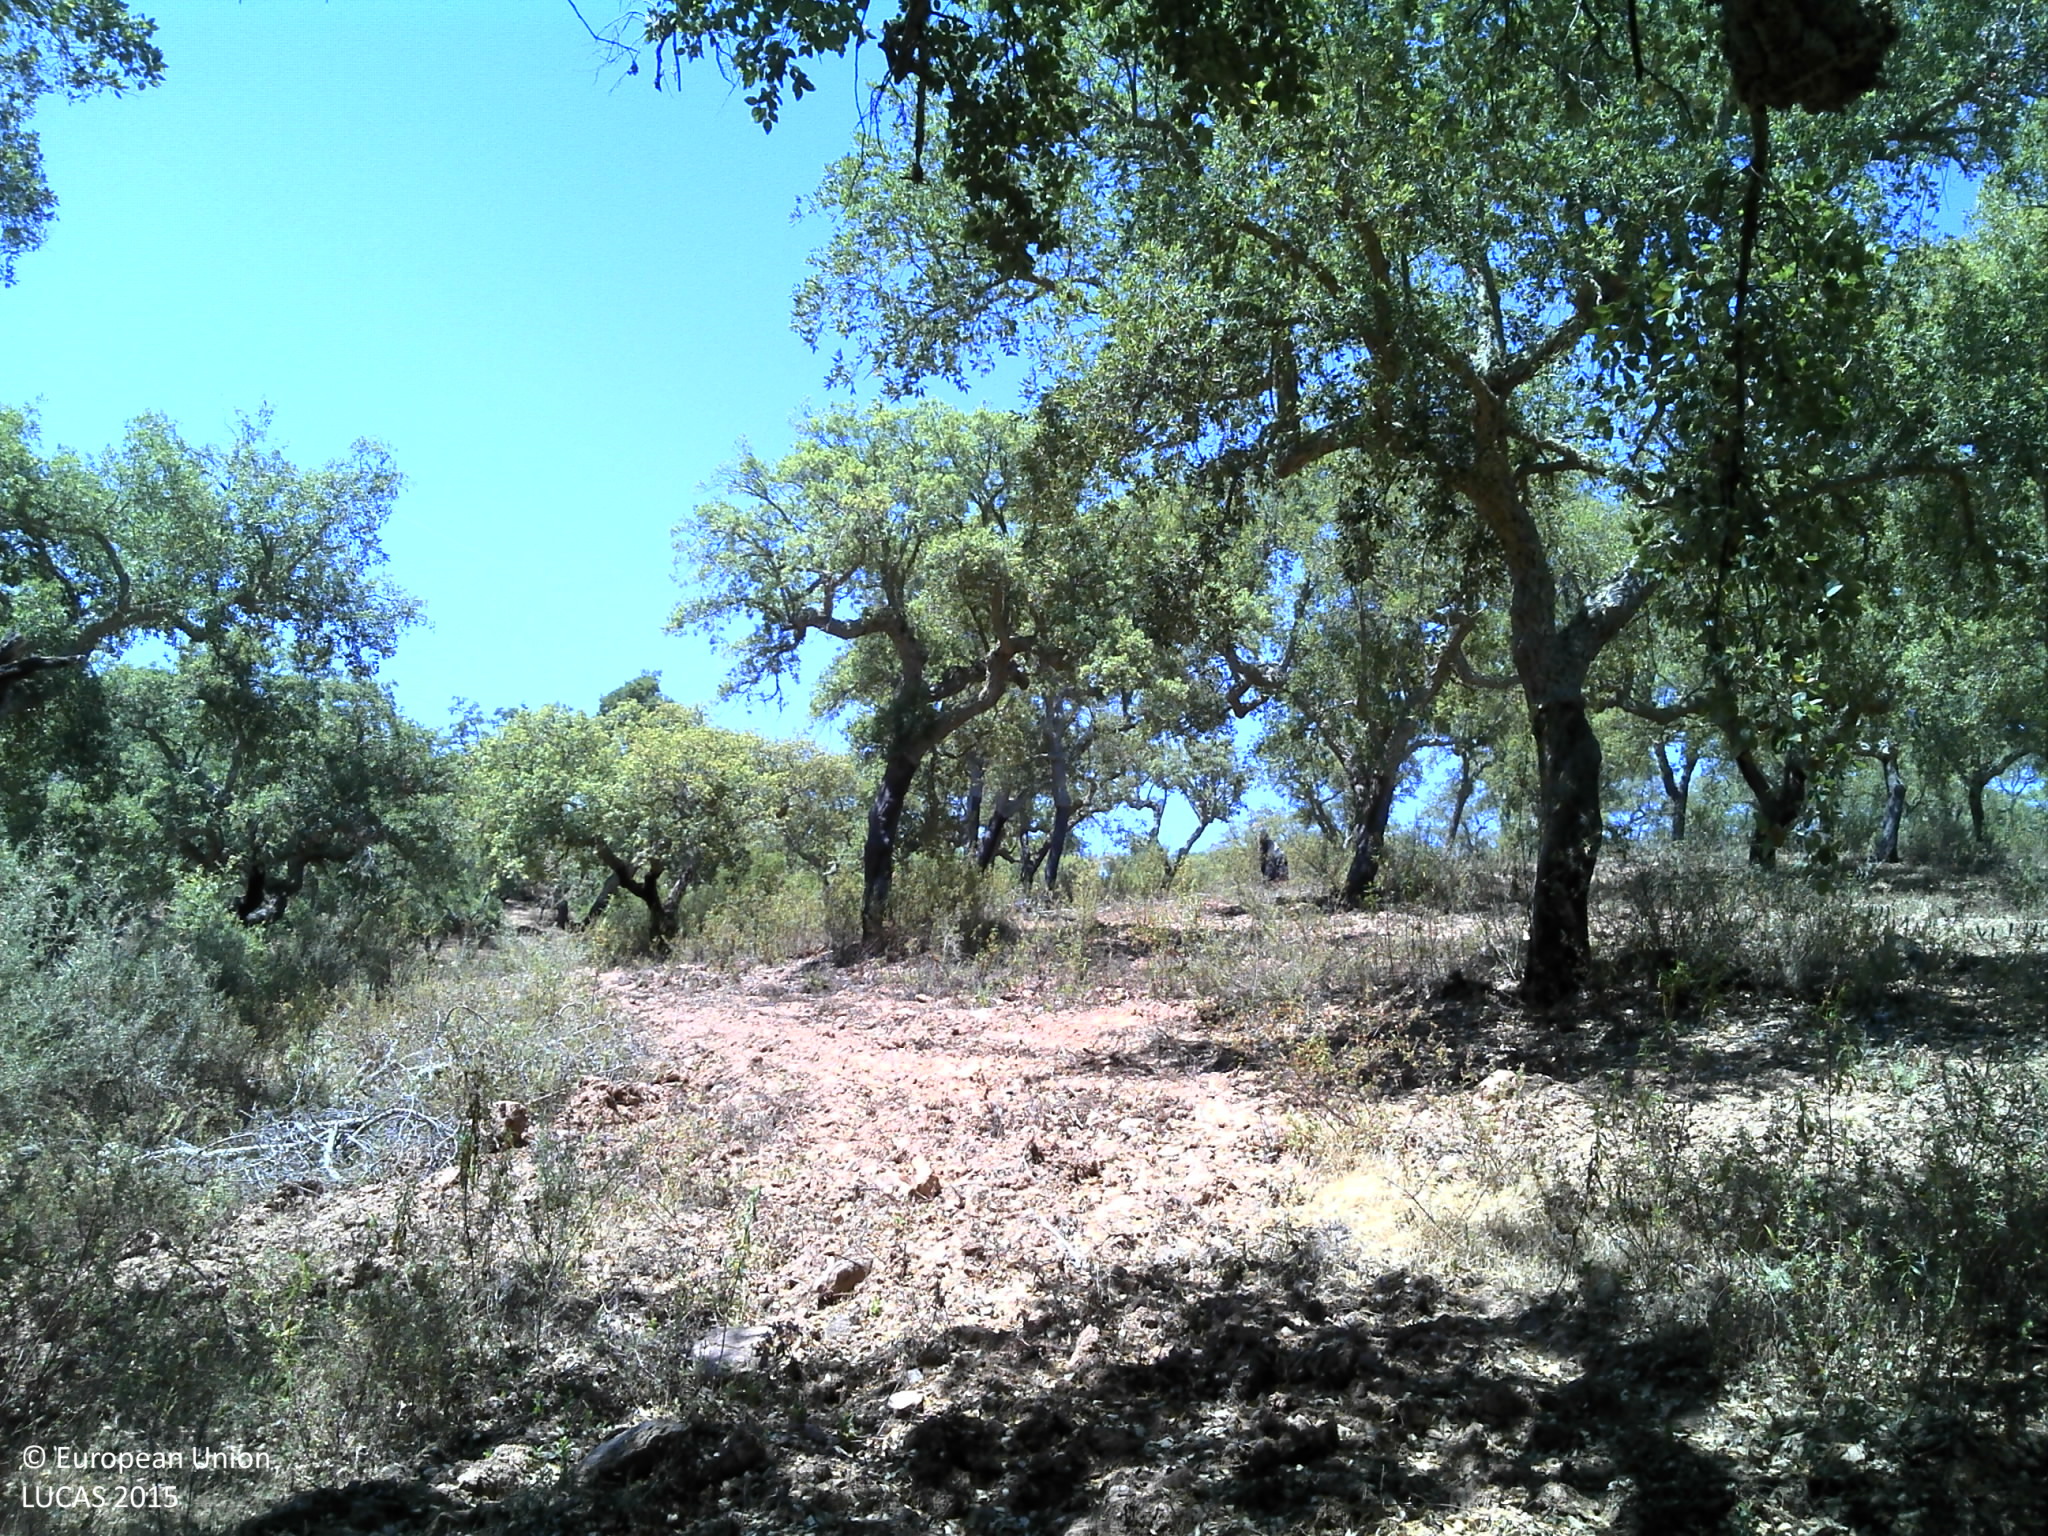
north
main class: Woodland
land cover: Broadleaved woodland
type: broadleaved evergreen forest
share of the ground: 25 - 50 %
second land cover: Grassland without tree/shrub cover
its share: 10 - 25 %
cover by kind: broadleaved forest trees 50 %, unconsolidated bare surface 35 %, herbaceous plants 15 %
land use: Forestry
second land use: Agriculture (excluding fallow land and kitchen gardens)
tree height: > 5 m
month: June
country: PT
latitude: 38.7851
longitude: -7.7332
